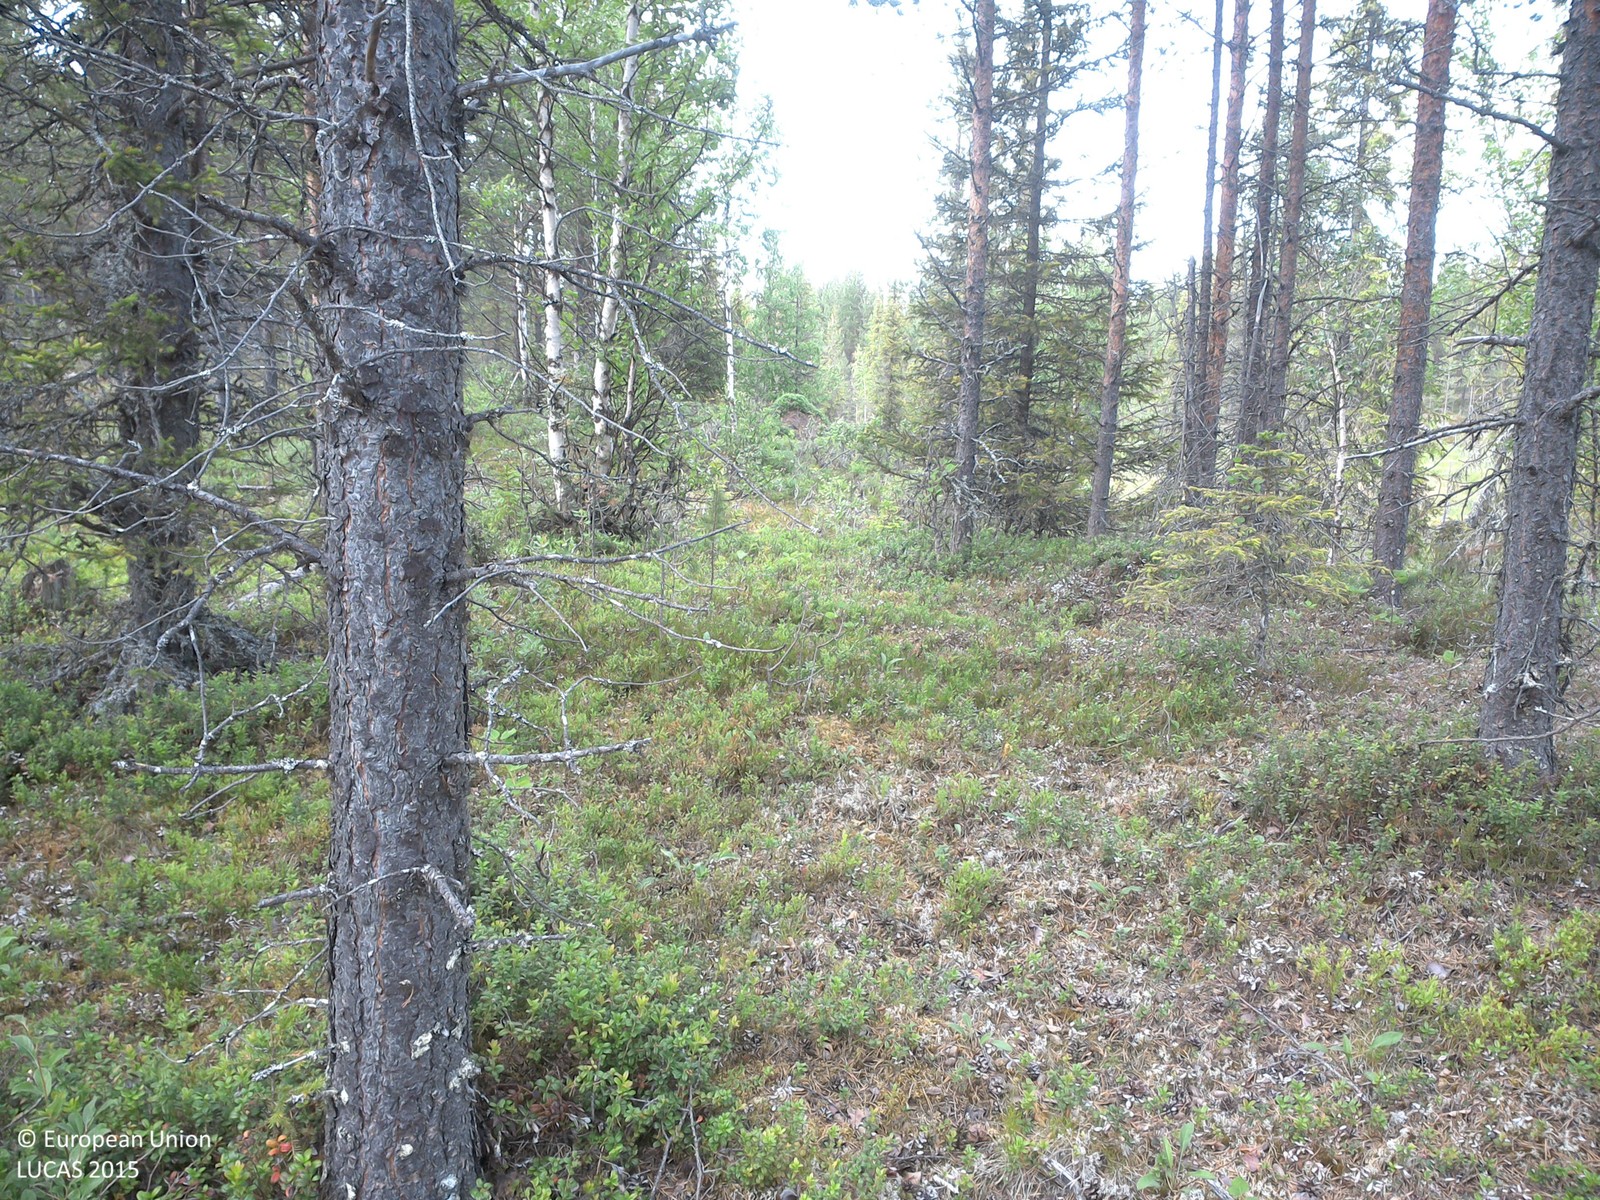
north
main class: Woodland
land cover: Pine dominated coniferous woodland
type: boreal forest
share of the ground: 25 - 50 %
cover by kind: lichens and mosses 40 %, coniferous forest trees 25 %, shrubs 25 %, broadleaved forest trees 5 %, herbaceous plants 5 %
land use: Forestry
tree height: > 5 m
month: July
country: SE
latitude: 67.5427
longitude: 22.1762
